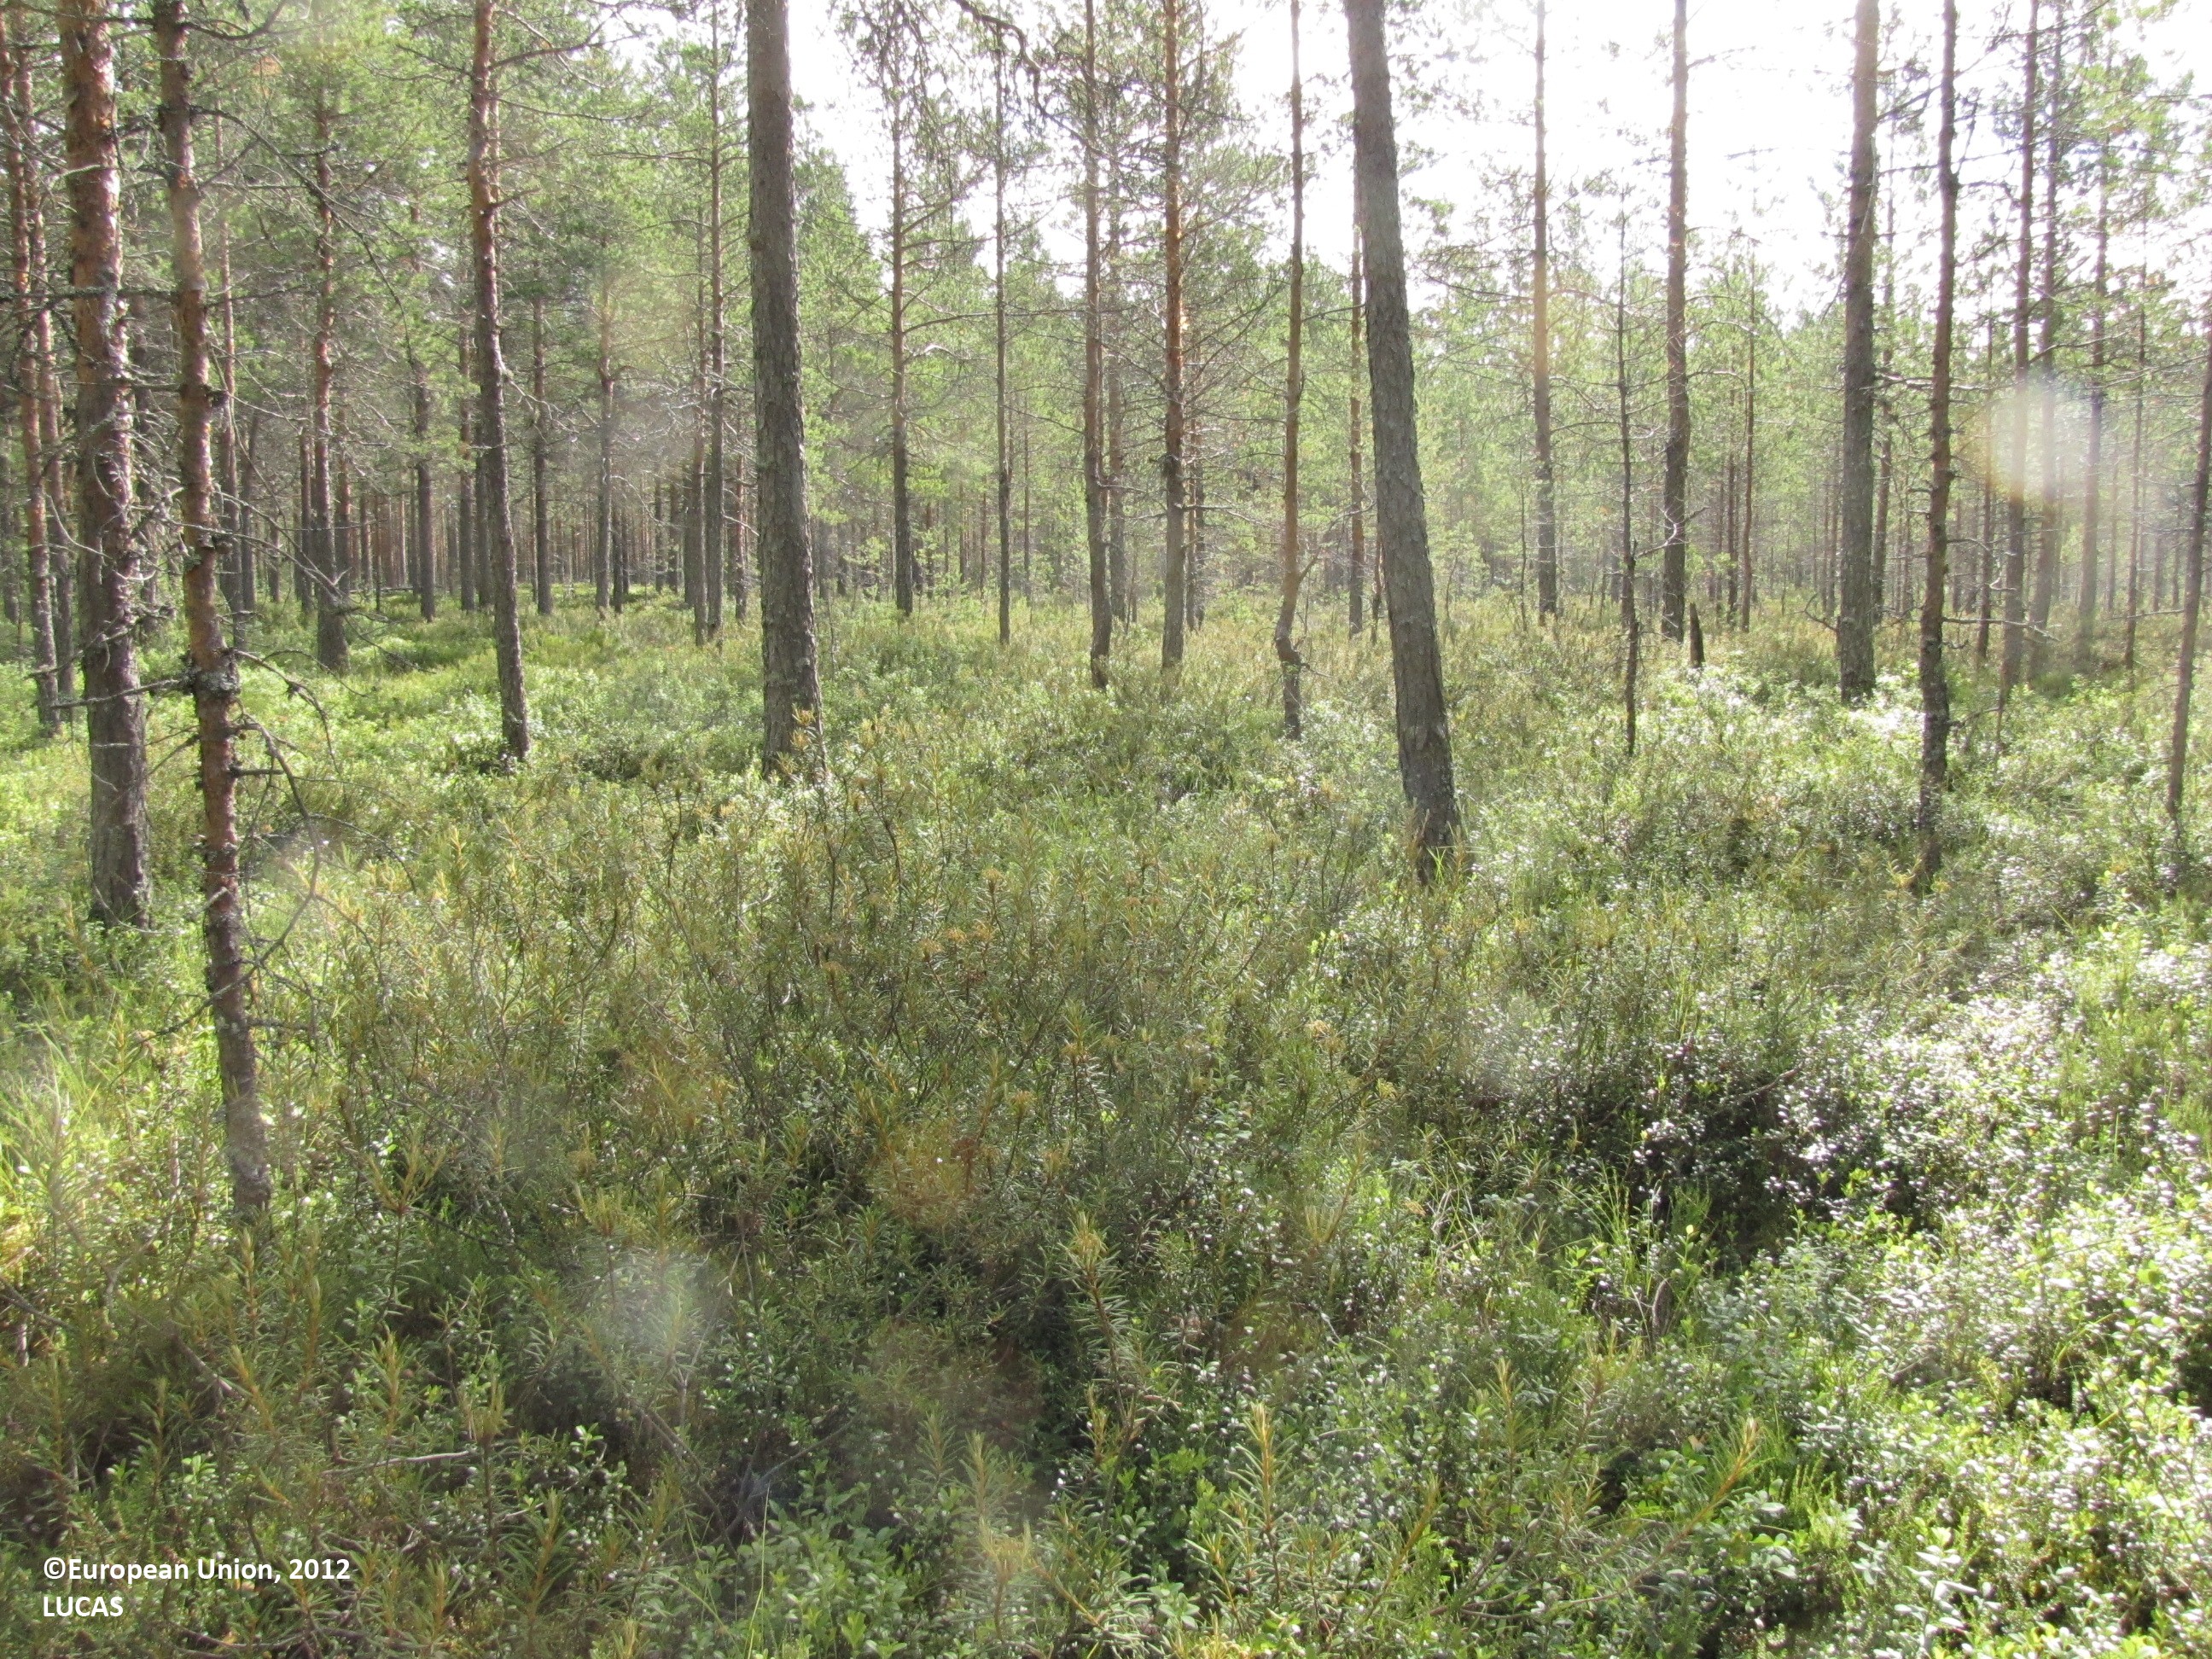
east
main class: Woodland
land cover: Pine dominated coniferous woodland
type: mire and swamp forests
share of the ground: 50 - 75 %
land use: Forestry
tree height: > 5 m
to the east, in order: Pine dominated coniferous woodland; Ditches and canals; Pine dominated coniferous woodland; Tracks; Pine dominated coniferous woodland; Ditches and canals; Pine dominated coniferous woodland
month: July
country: FI
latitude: 62.3978
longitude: 23.1639
